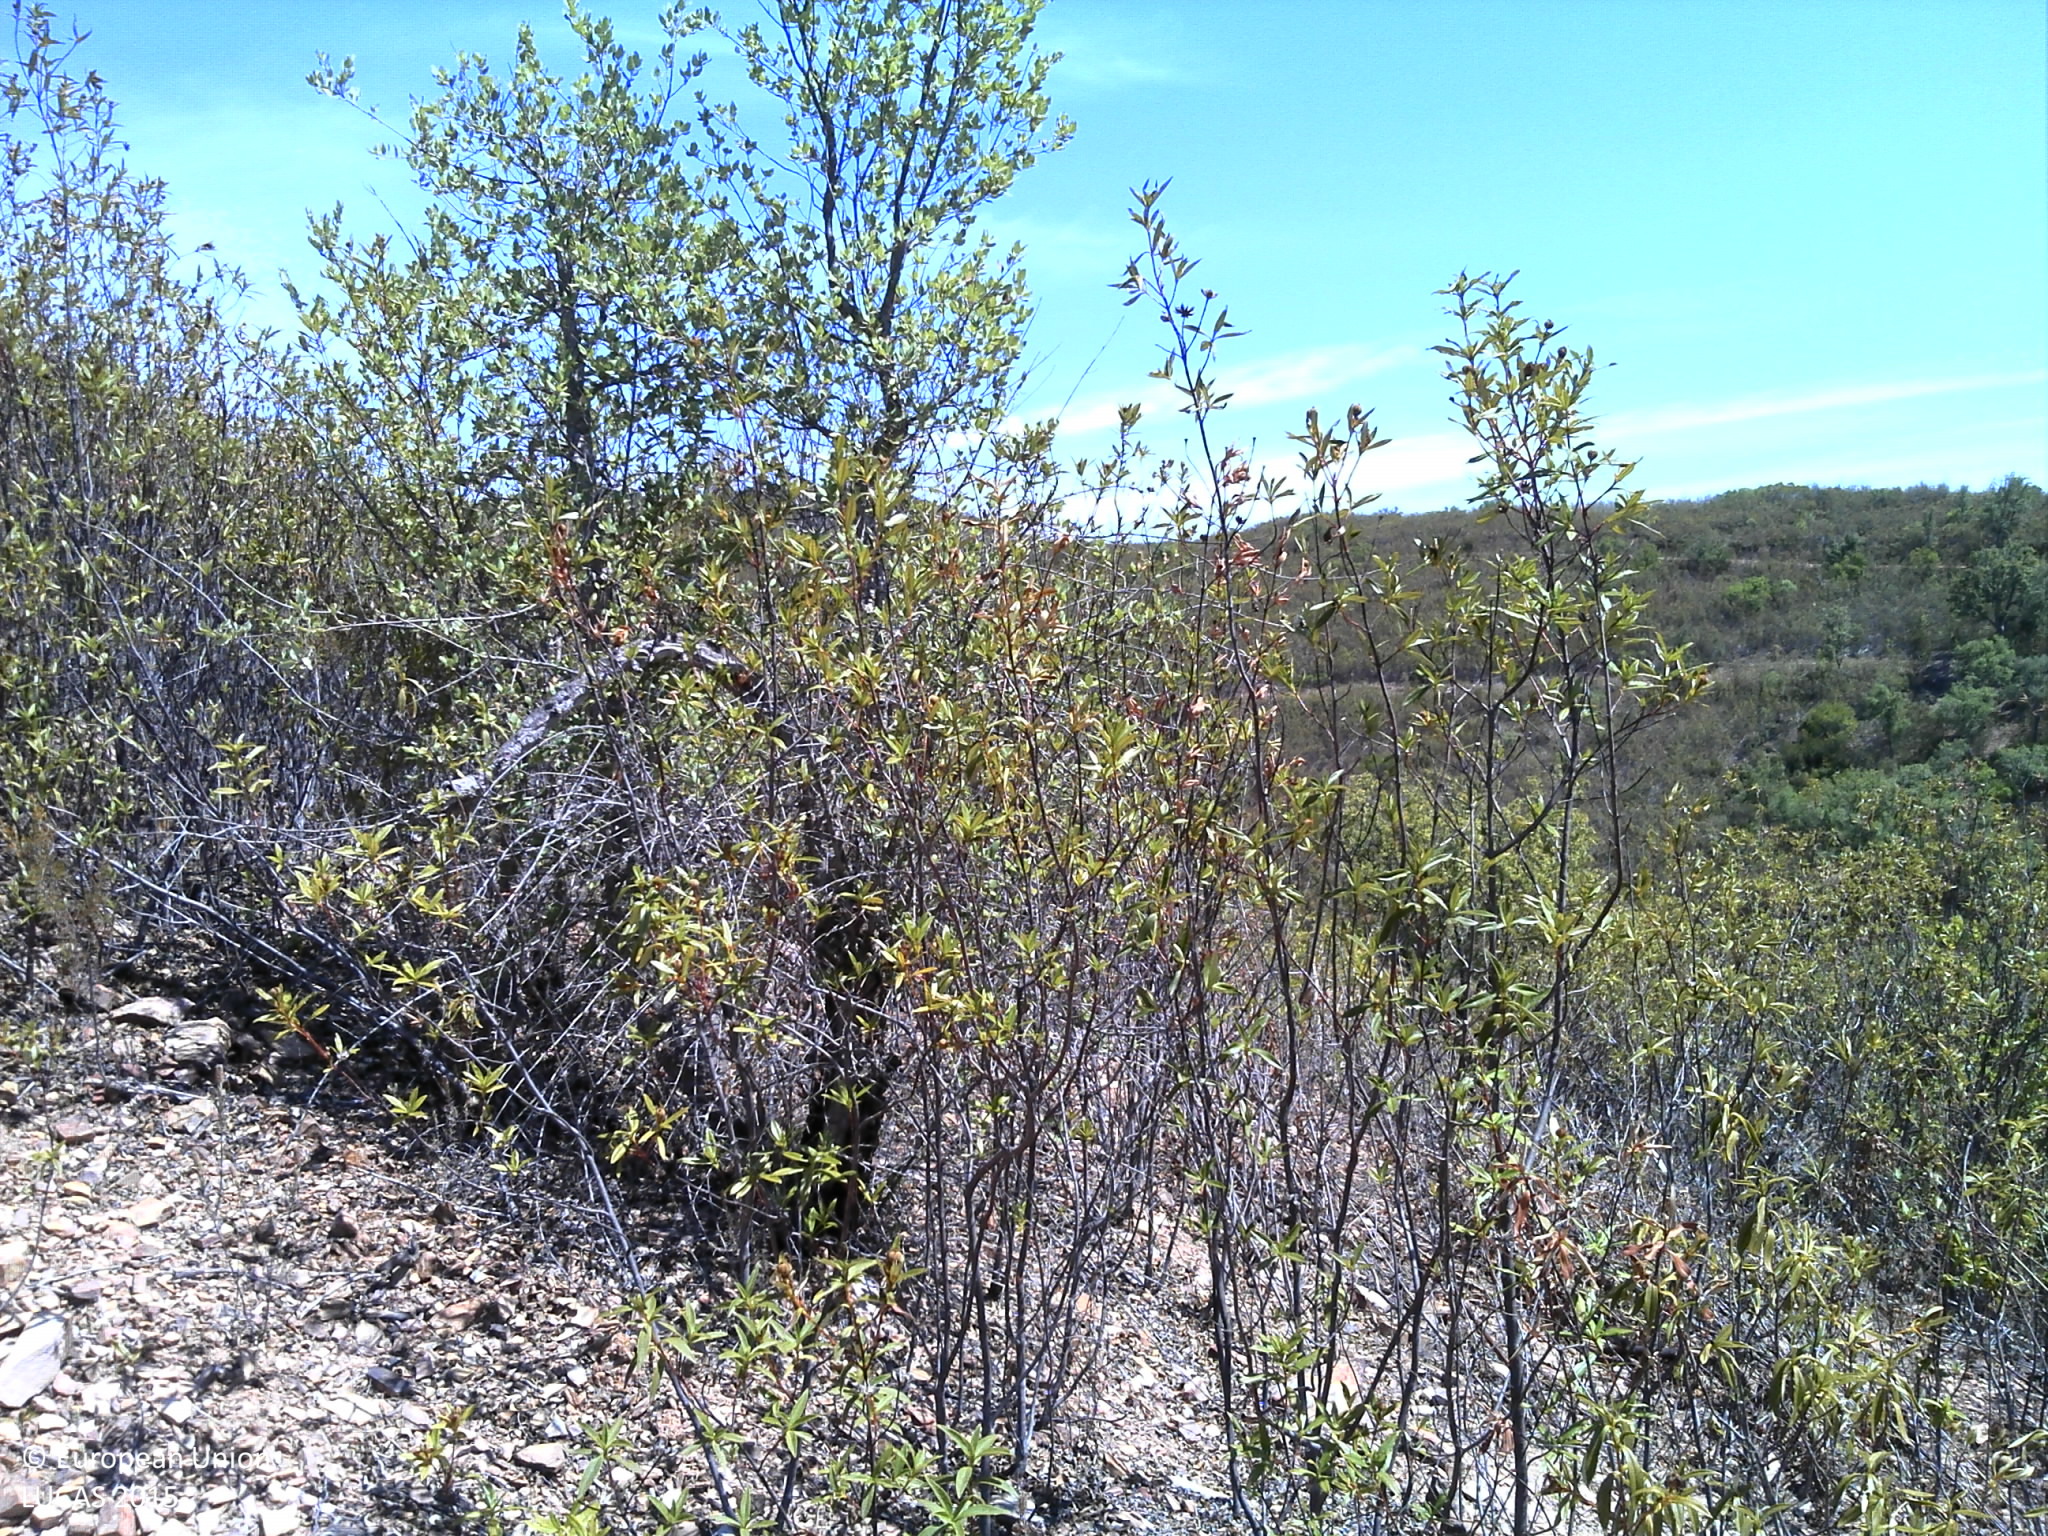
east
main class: Shrubland
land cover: Shrubland with sparse tree cover
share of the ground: 50 - 75 %
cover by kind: shrubs 60 %, unconsolidated bare surface 30 %, broadleaved forest trees 5 %, herbaceous plants 5 %
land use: Forestry
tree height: < 5 m
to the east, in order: Shrubland with sparse tree cover; Tracks; Shrubland with sparse tree cover; Tracks; Shrubland without tree cover; Rivers and streams; Shrubland without tree cover; Tracks; Shrubland without tree cover
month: September
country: PT
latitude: 37.3883
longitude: -8.1727
